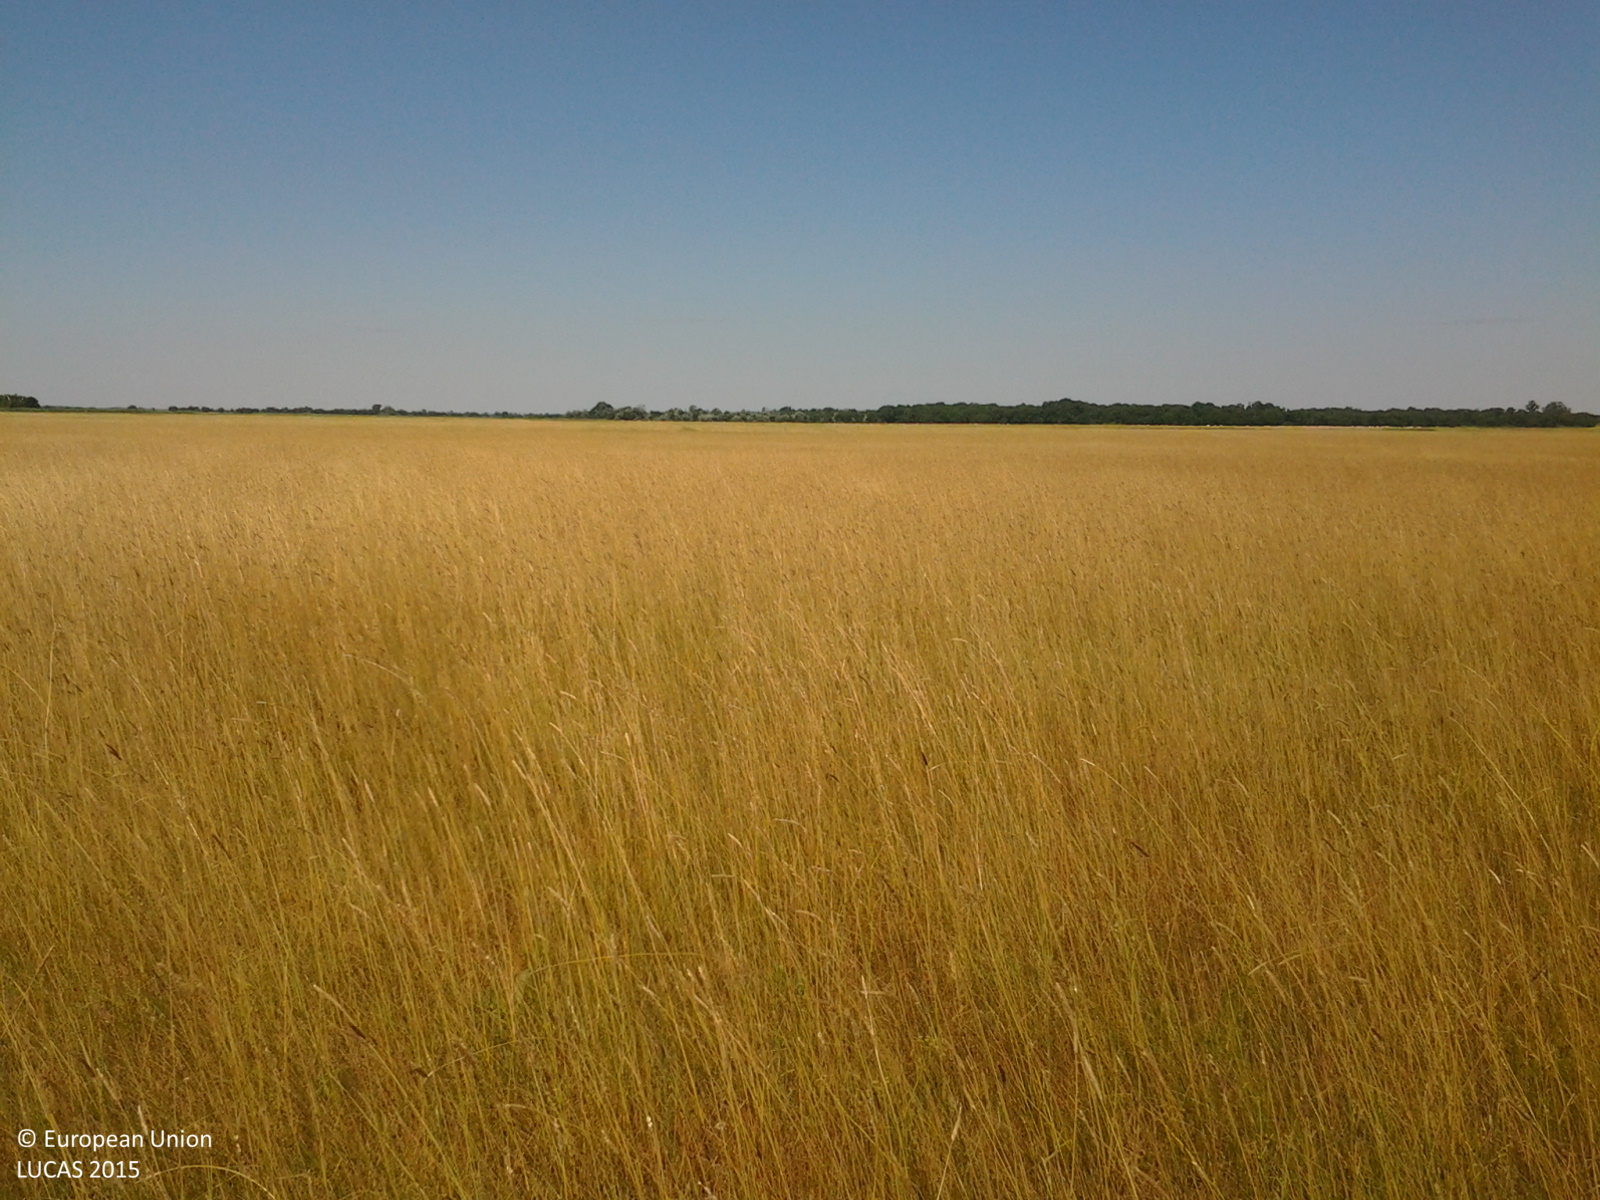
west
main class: Grassland
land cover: Grassland without tree/shrub cover
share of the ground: > 75 %
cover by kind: herbaceous plants 100 %
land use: Agriculture (excluding fallow land and kitchen gardens)
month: June
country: HU
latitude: 46.6003
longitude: 21.1696
